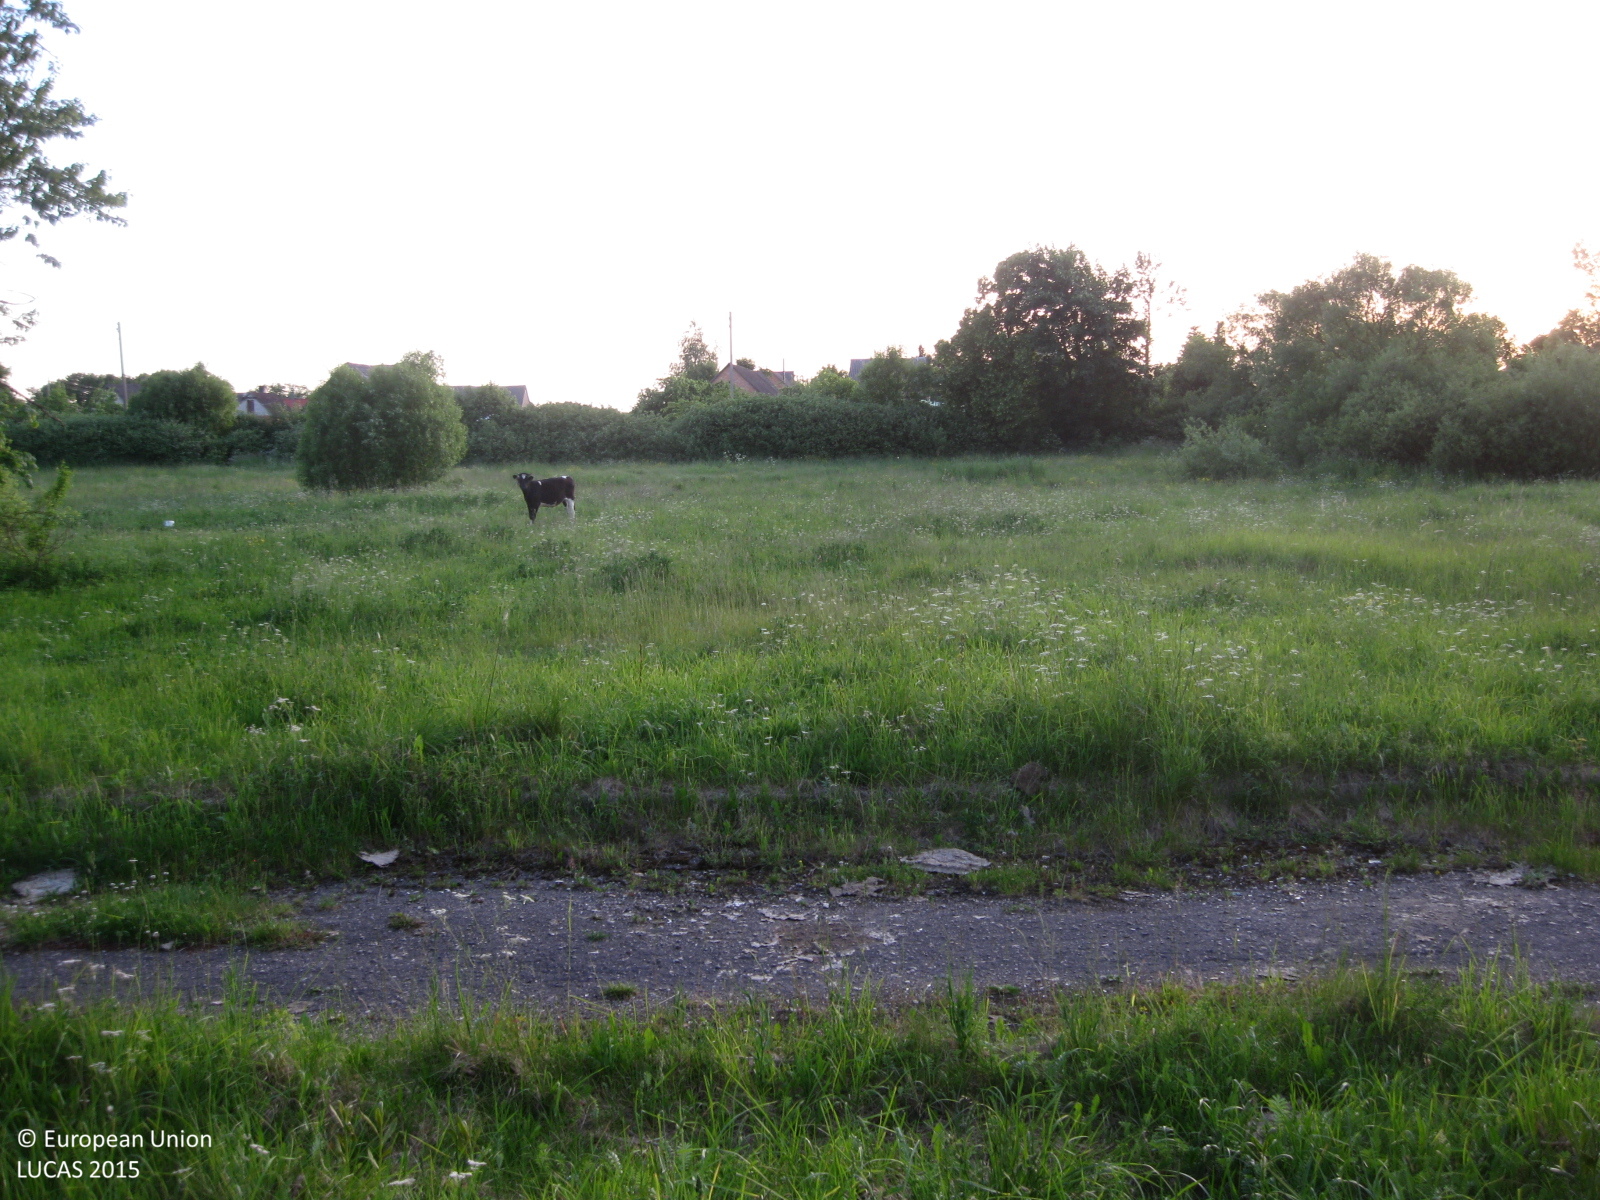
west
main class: Grassland
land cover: Grassland with sparse tree/shrub cover
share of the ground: > 75 %
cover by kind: herbaceous plants 90 %, coniferous forest trees 5 %, shrubs 5 %
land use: Abandoned areas
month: June
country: LT
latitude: 55.4521
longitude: 23.6645
